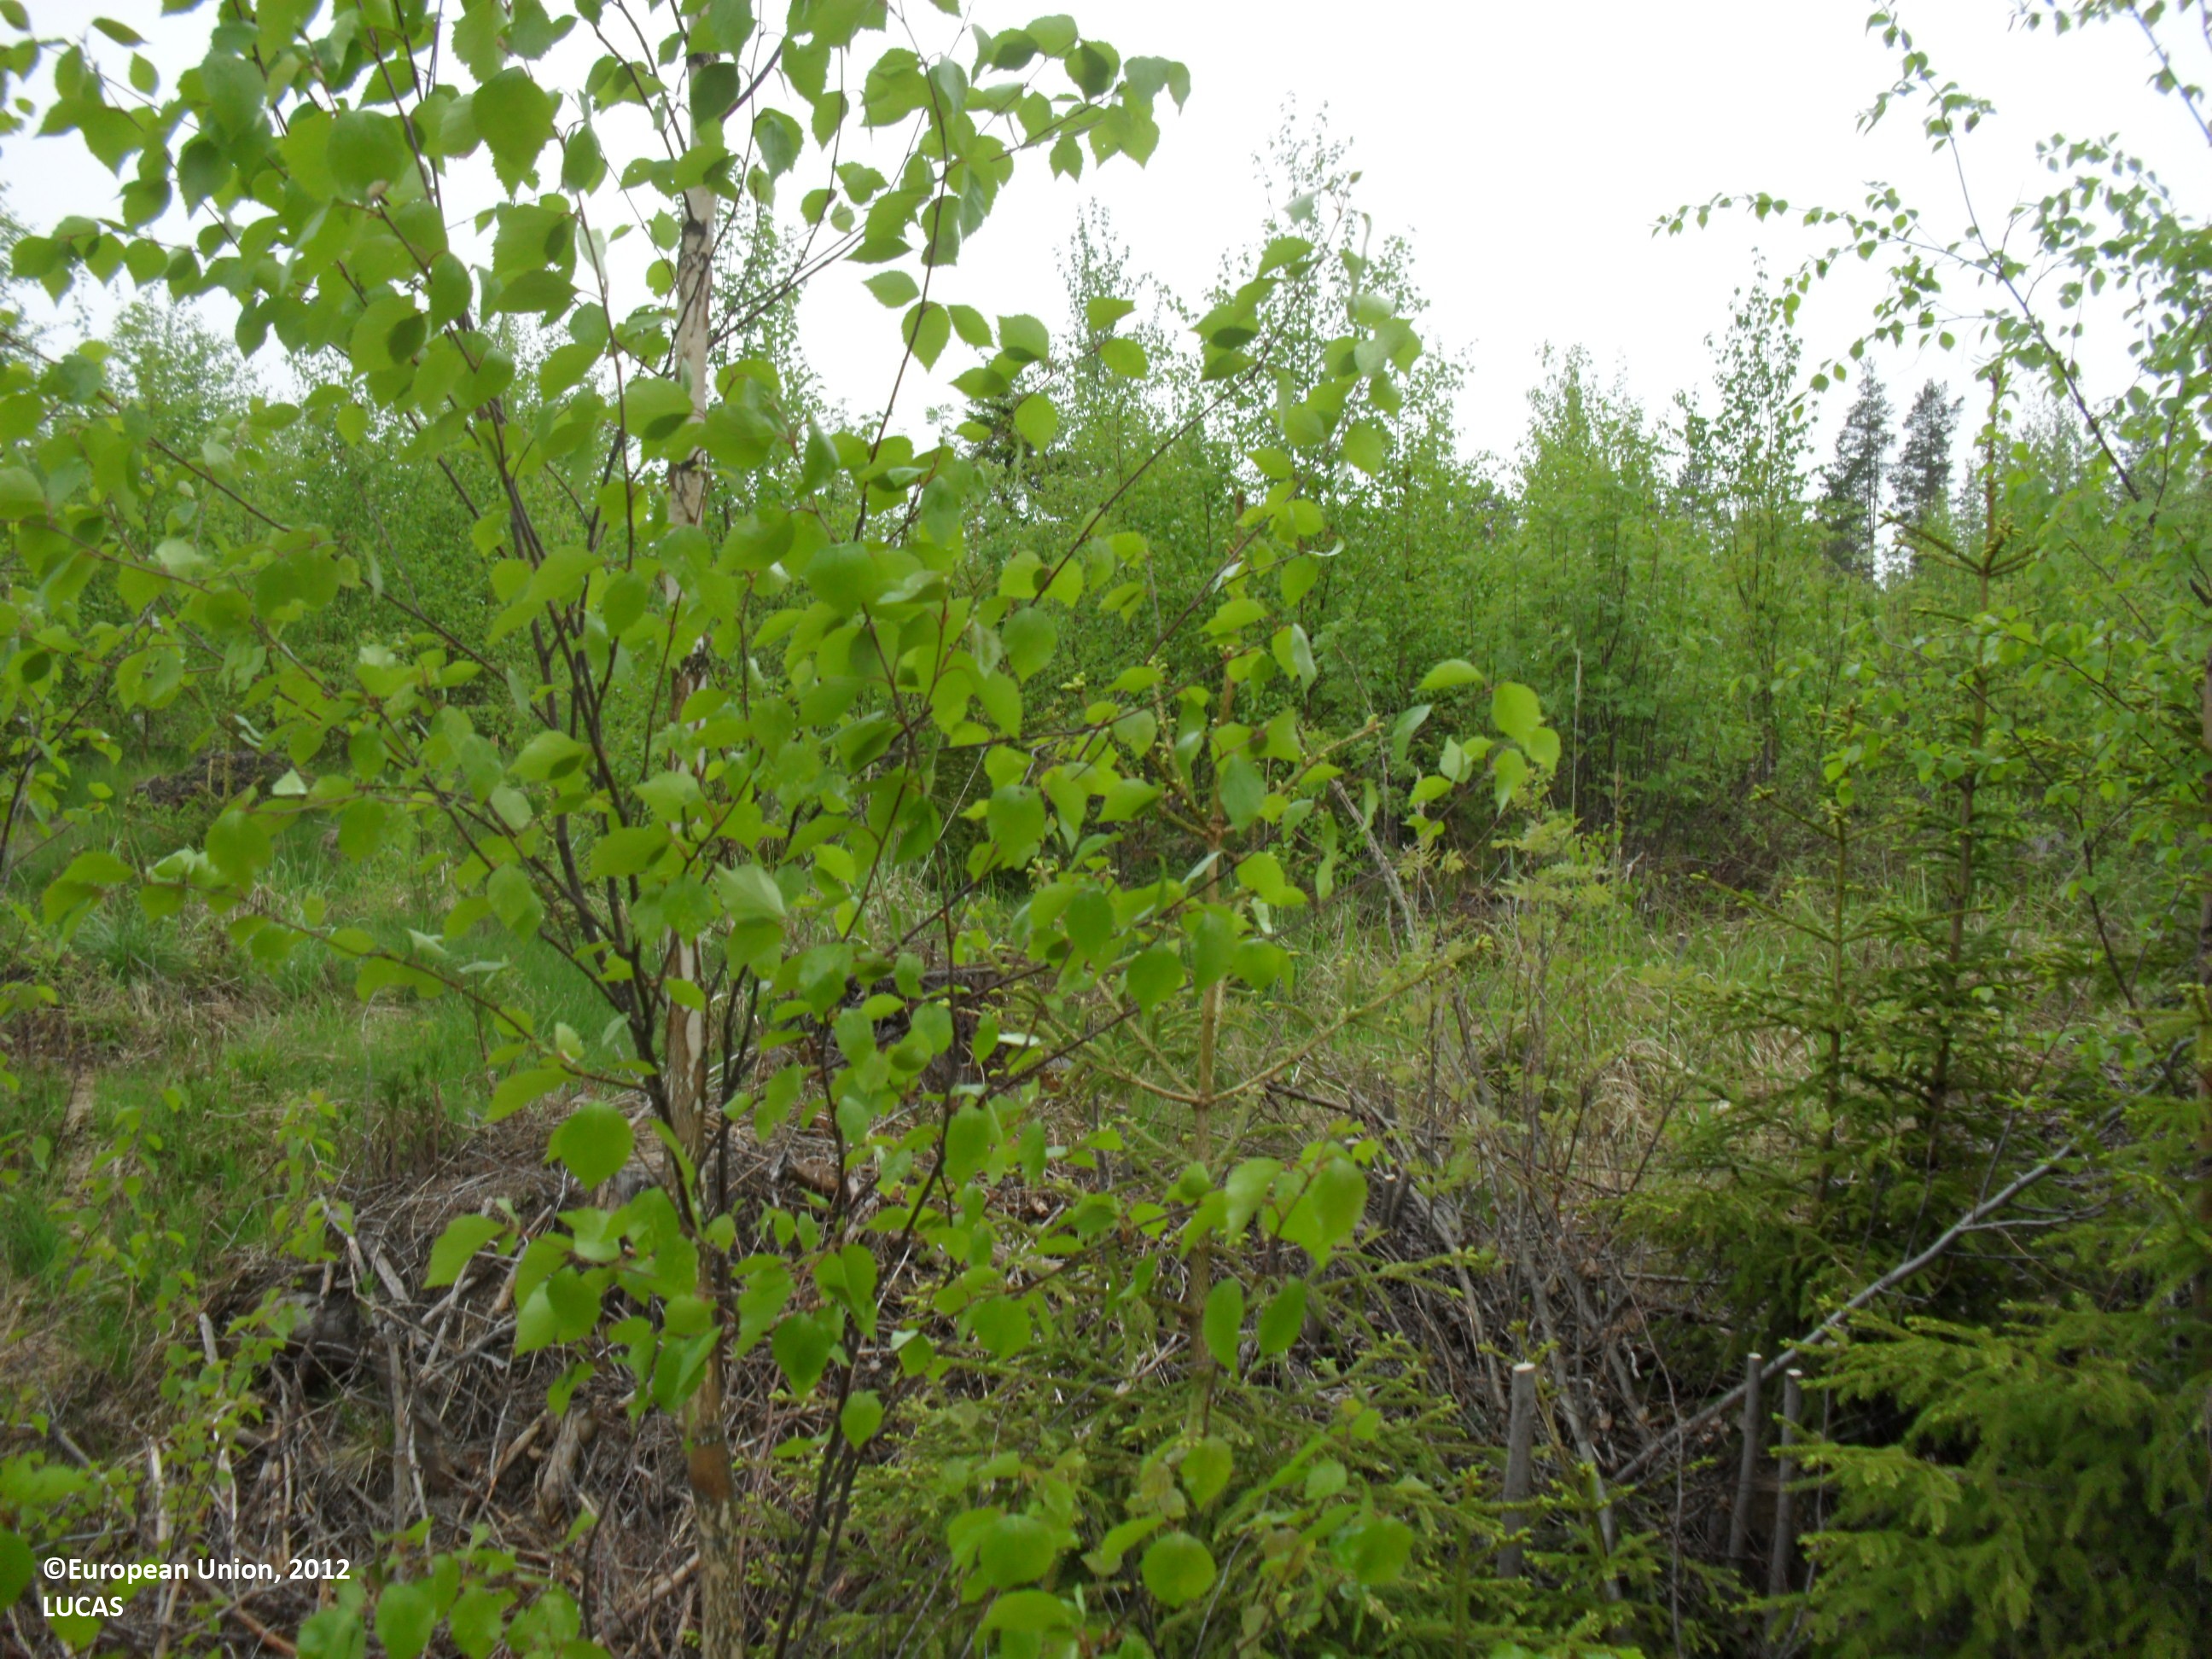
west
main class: Grassland
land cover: Grassland with sparse tree/shrub cover
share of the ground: 10 - 25 %
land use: Semi-natural and natural areas not in use
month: June
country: FI
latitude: 63.0358
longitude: 23.2072
